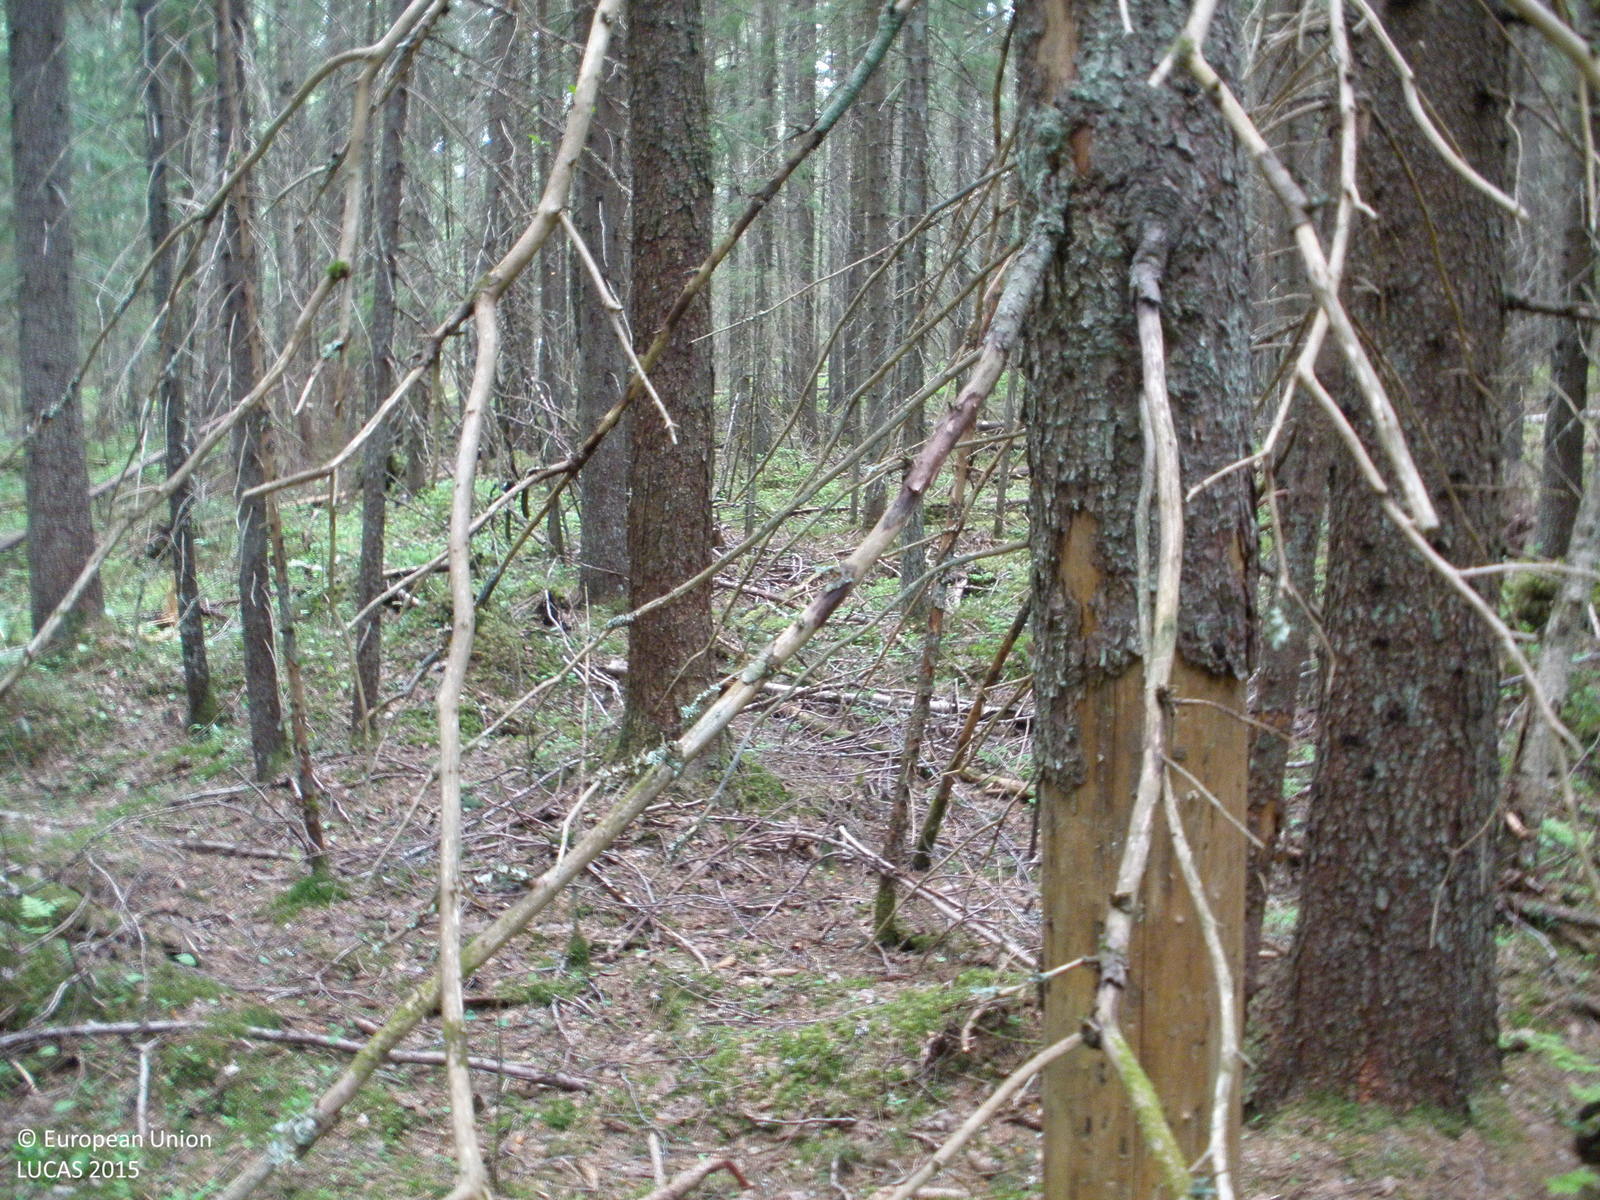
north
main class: Woodland
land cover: Spruce dominated mixed woodland
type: boreal forest
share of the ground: > 75 %
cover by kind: coniferous forest trees 65 %, broadleaved forest trees 25 %, shrubs 5 %, herbaceous plants 5 %
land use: Forestry
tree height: > 5 m
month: June
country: FI
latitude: 60.7234
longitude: 24.0084
